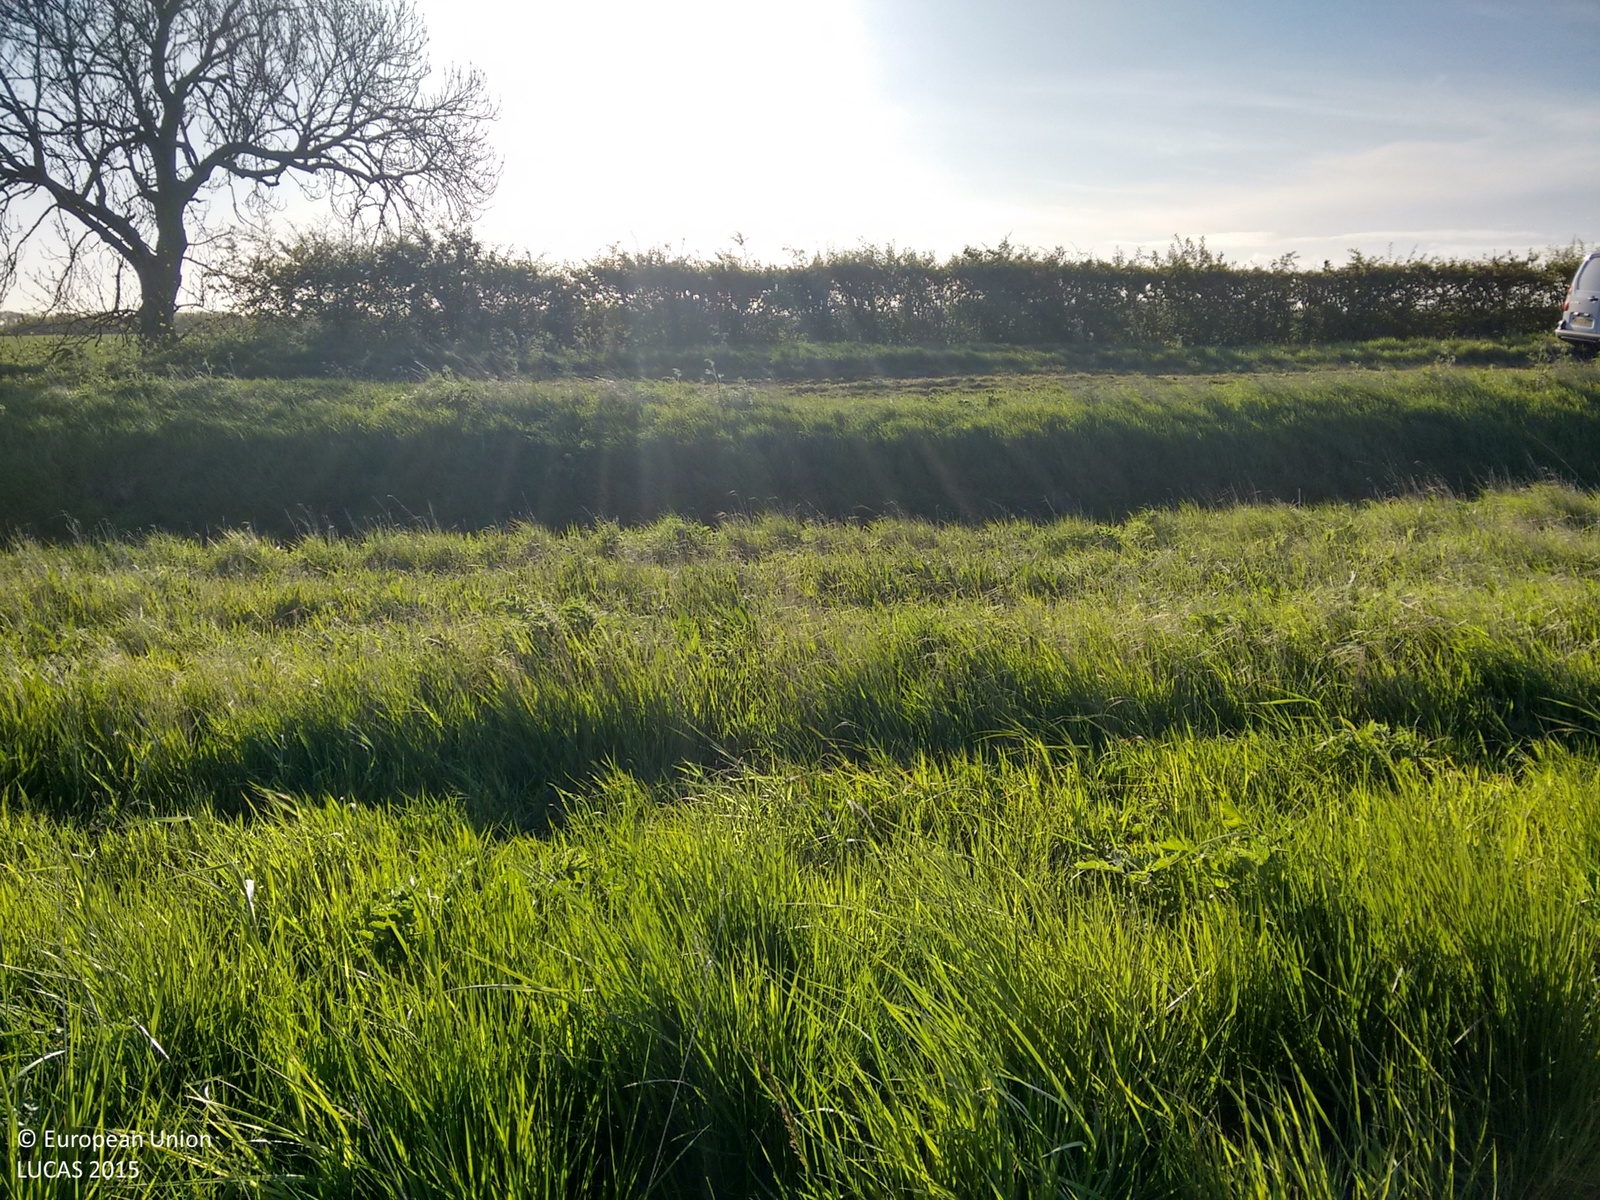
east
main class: Cropland
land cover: Rape and turnip rape
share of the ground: > 75 %
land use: Agriculture (excluding fallow land and kitchen gardens)
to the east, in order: Rape and turnip rape; Grassland without tree/shrub cover; Ditches and canals; Managed hedges; Grassland without tree/shrub cover; Tracks; Grassland without tree/shrub cover; Managed hedges; Ditches and canals; Grassland without tree/shrub cover; Common wheat
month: May
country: GB
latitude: 53.0711
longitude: -0.0776
